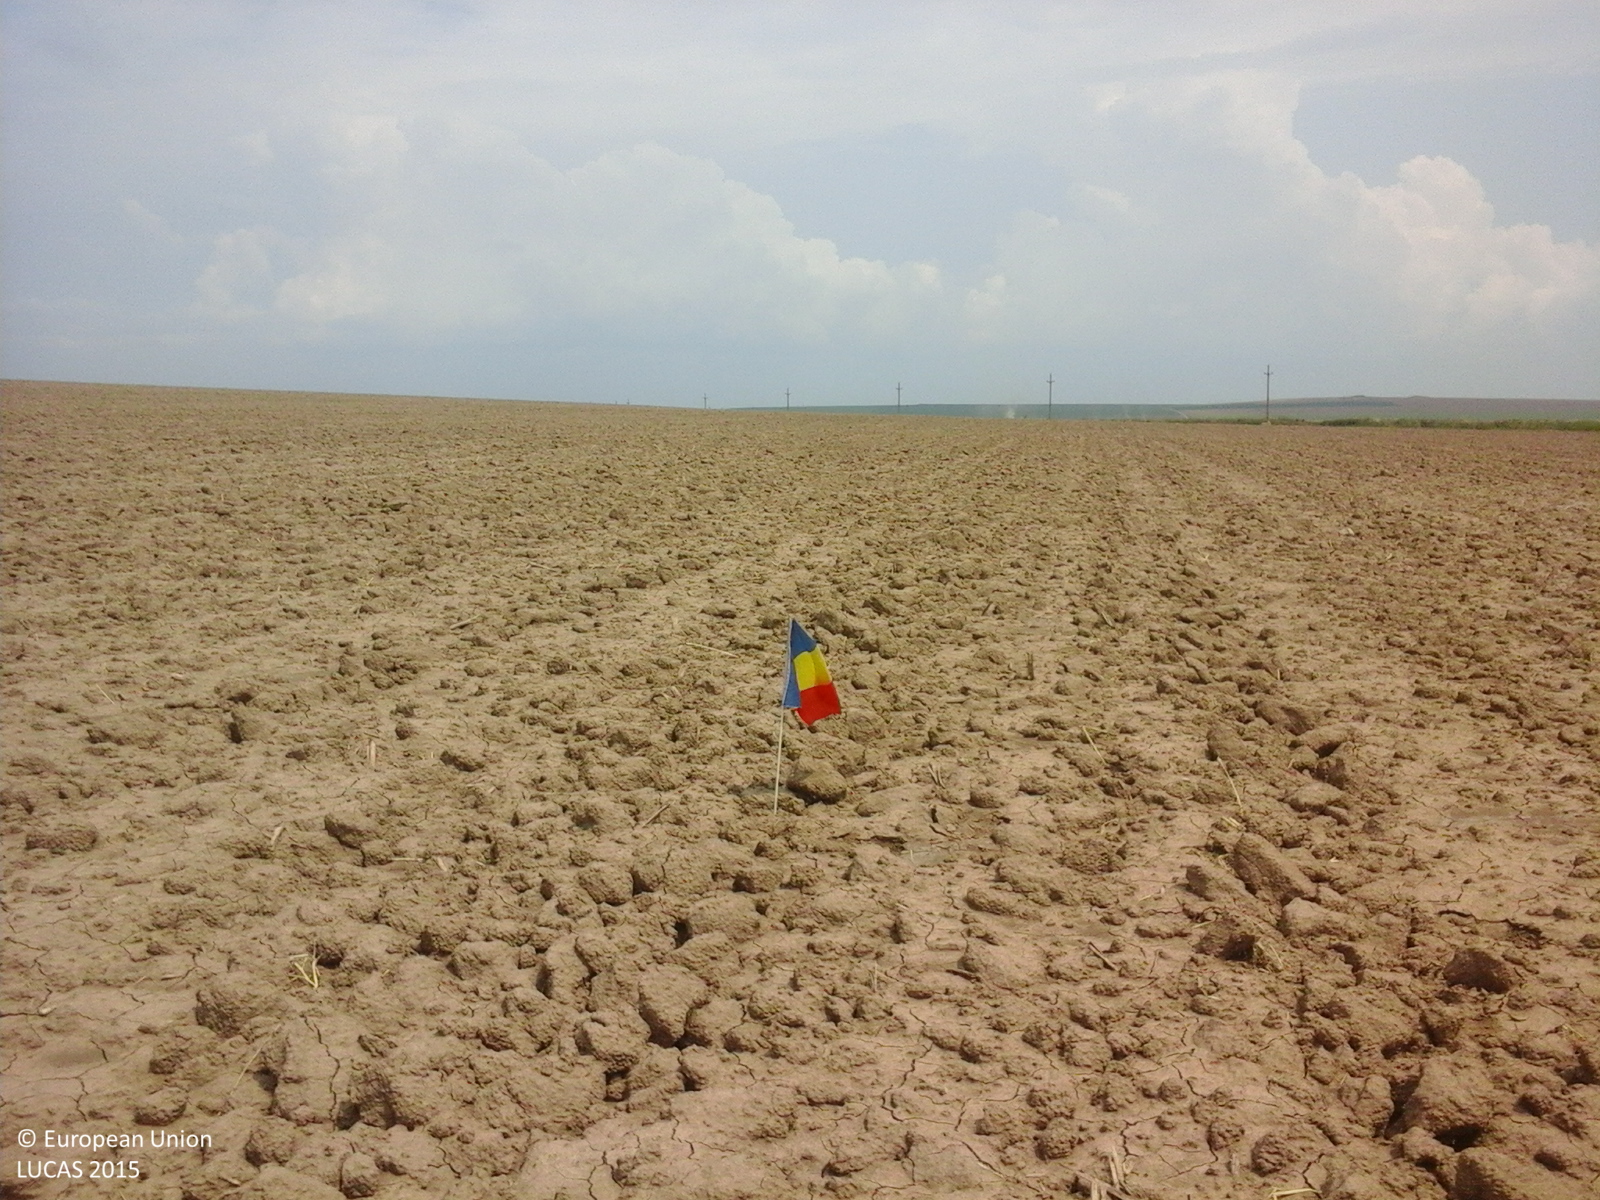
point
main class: Cropland
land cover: Common wheat
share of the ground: < 10 %
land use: Agriculture (excluding fallow land and kitchen gardens)
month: July
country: RO
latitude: 44.9798
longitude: 28.7929
